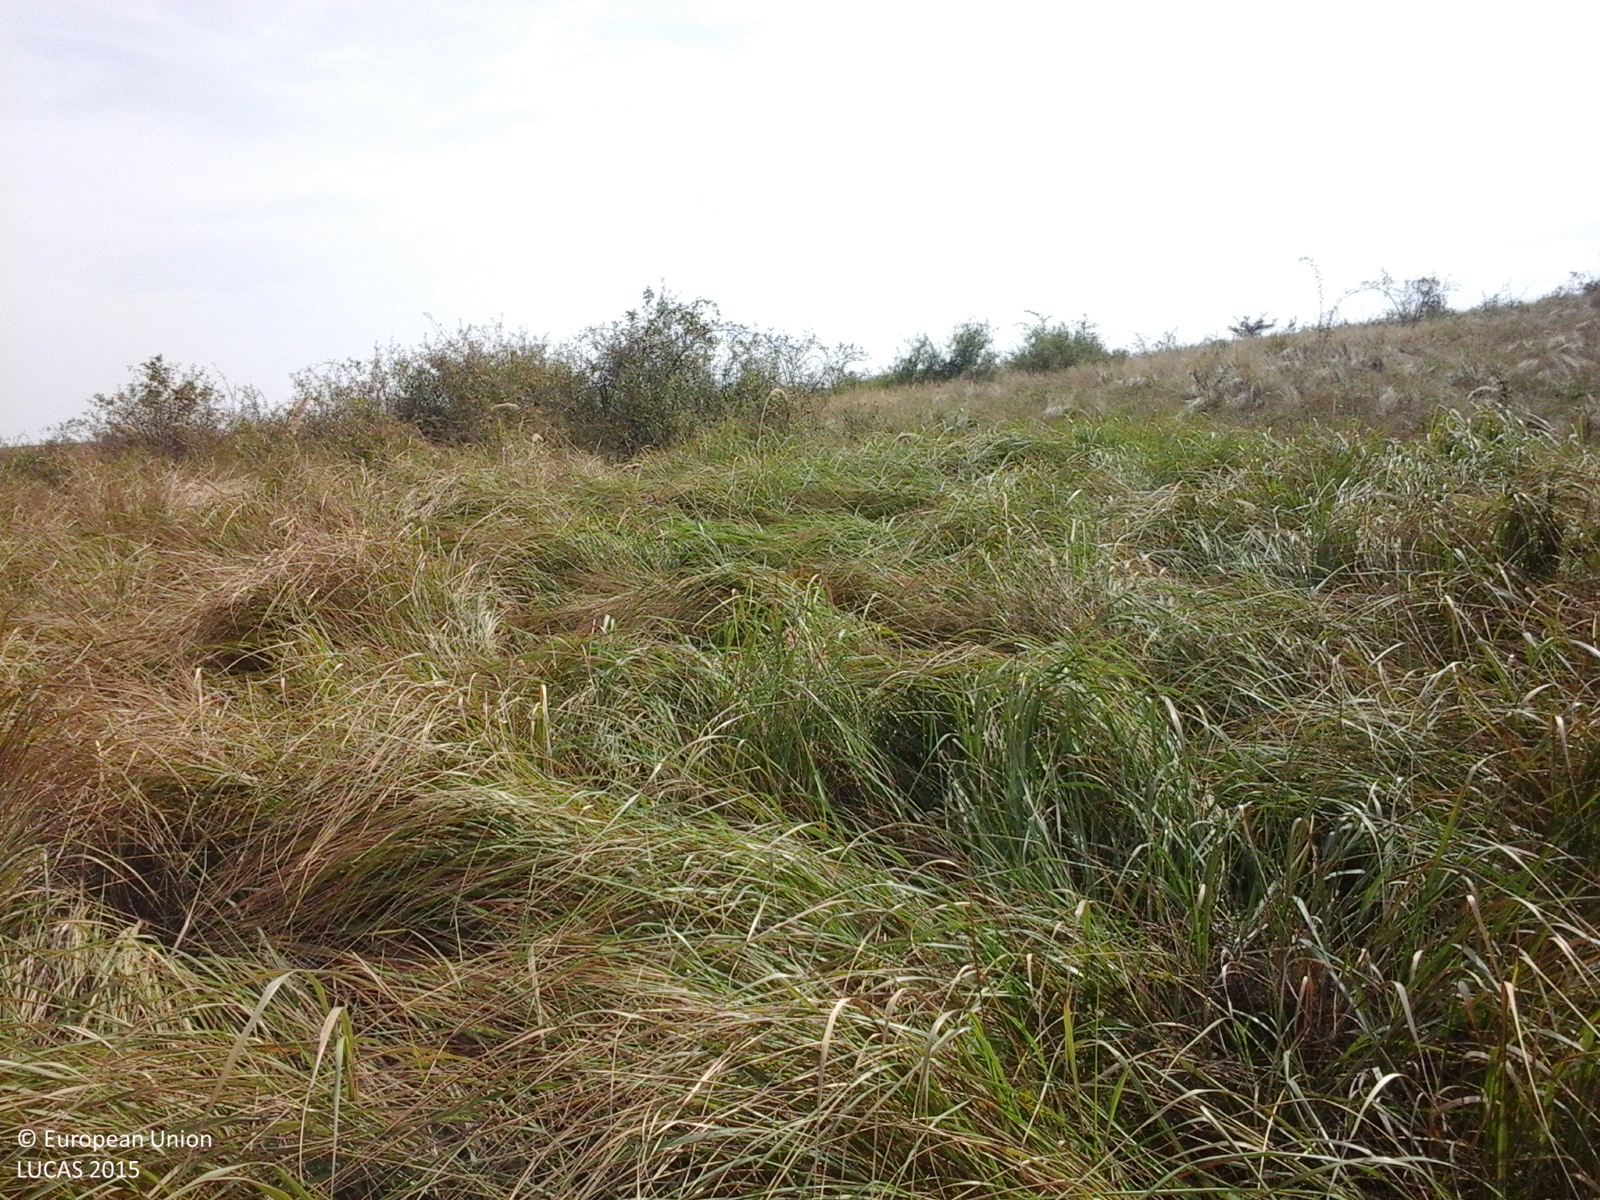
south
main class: Grassland
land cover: Grassland with sparse tree/shrub cover
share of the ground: > 75 %
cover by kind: herbaceous plants 85 %, shrubs 10 %, broadleaved forest trees 5 %
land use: Agriculture (excluding fallow land and kitchen gardens)
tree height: < 5 m
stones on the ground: < 10 %
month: September
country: RO
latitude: 46.8665
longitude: 23.7306
